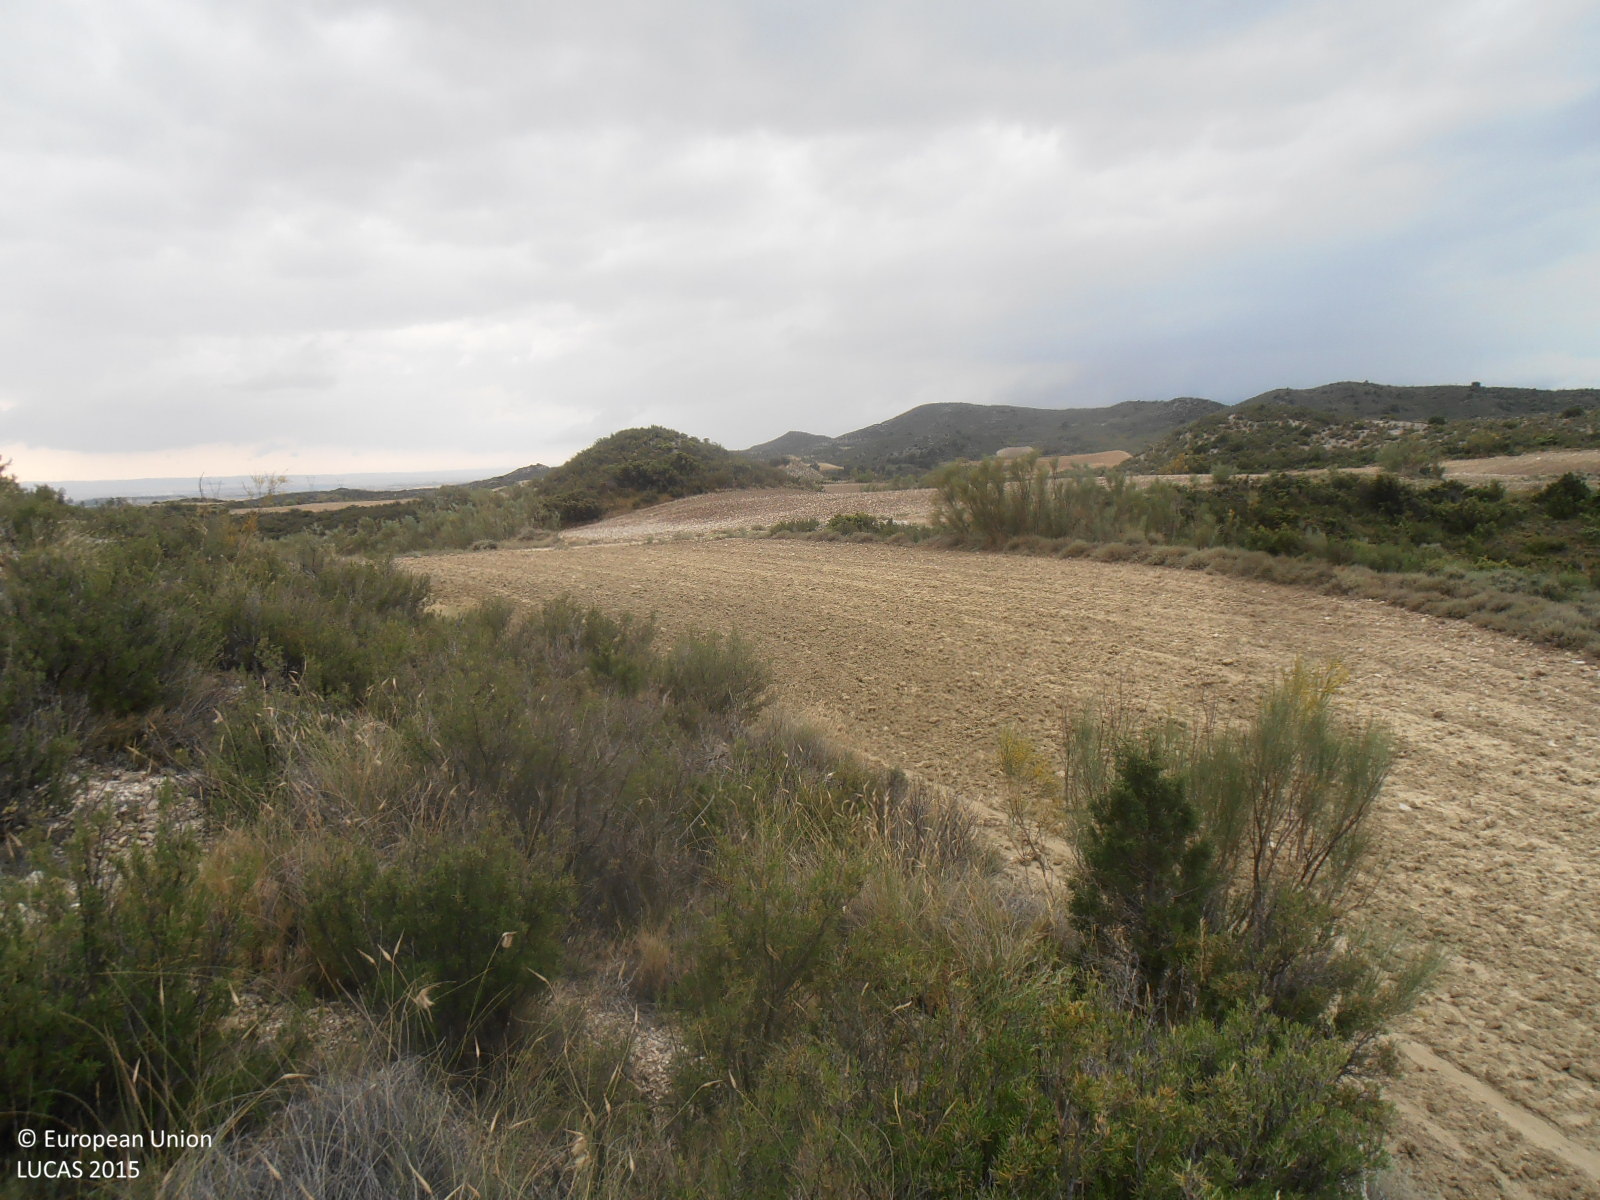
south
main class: Shrubland
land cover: Shrubland without tree cover
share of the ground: 50 - 75 %
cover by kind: shrubs 55 %, consolidated bare surface 45 %
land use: Semi-natural and natural areas not in use
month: June
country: ES
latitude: 41.9069
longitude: -0.8373
